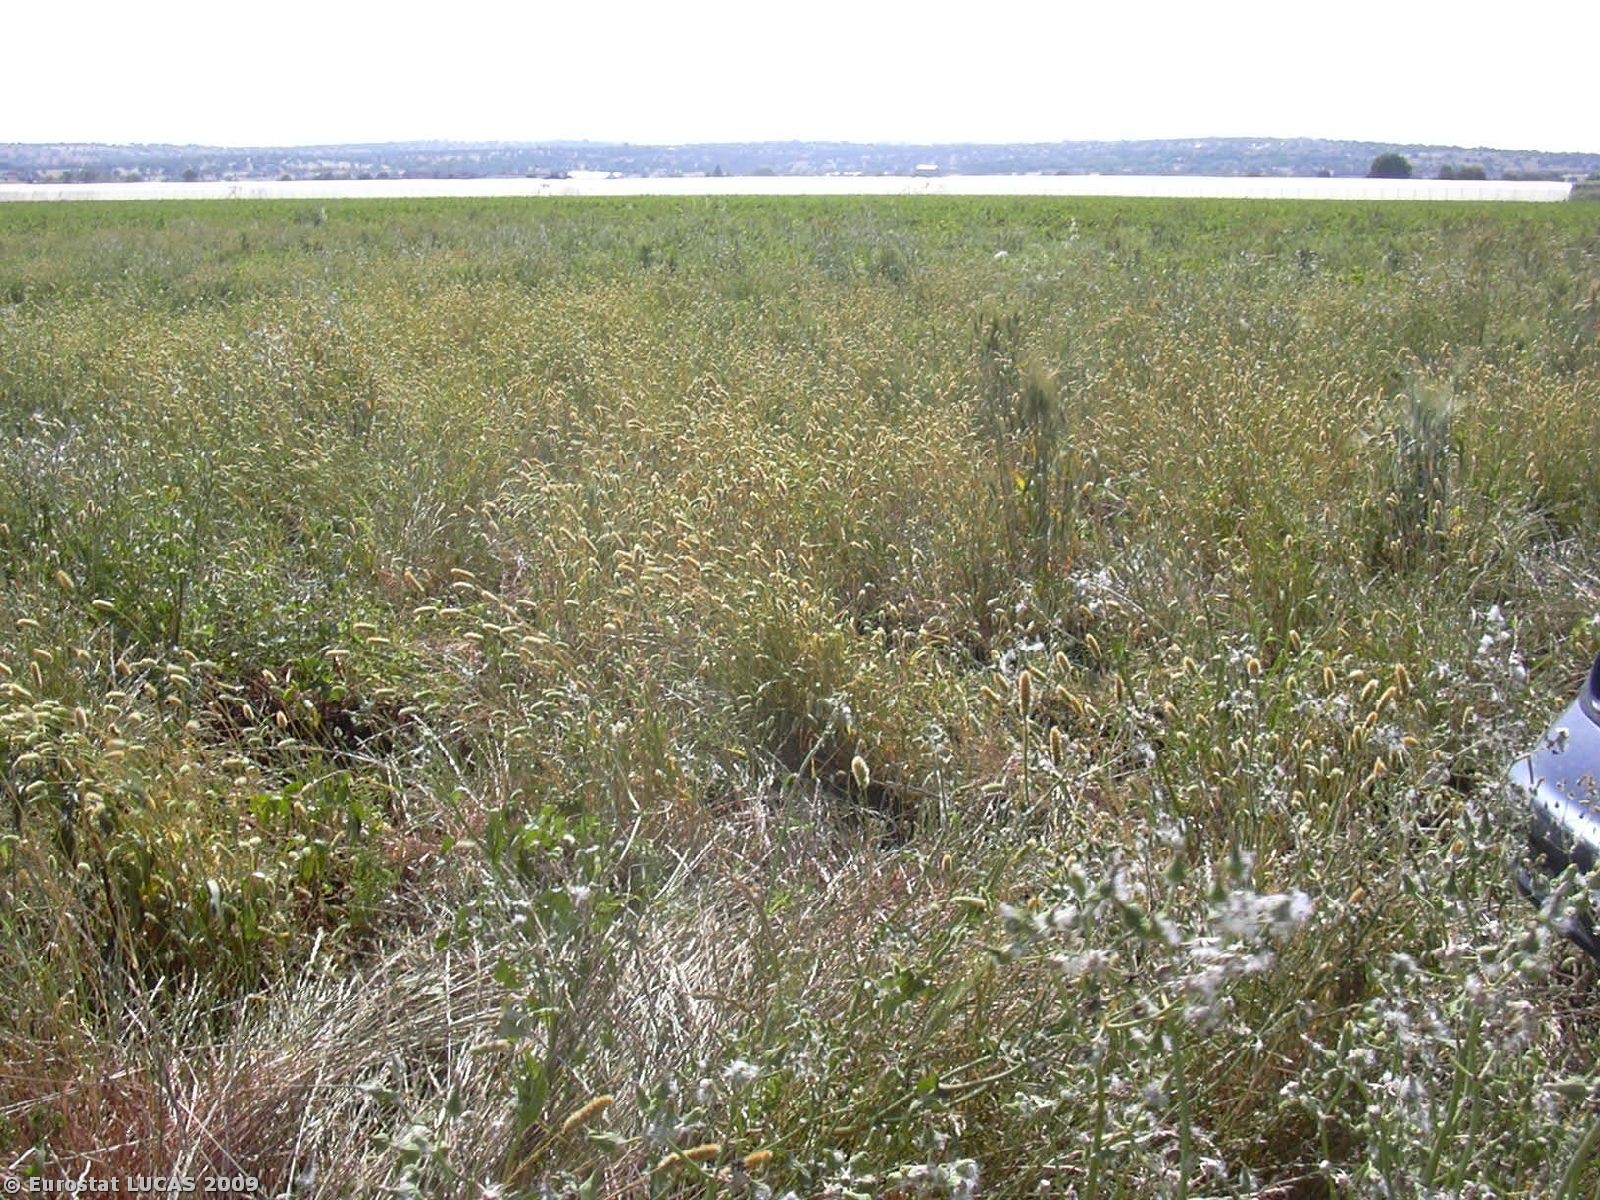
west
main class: Cropland
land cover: Durum wheat
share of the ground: > 75 %
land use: Agriculture (excluding fallow land and kitchen gardens)
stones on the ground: < 10 %
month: May
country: IT
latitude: 36.8036
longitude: 14.8812
